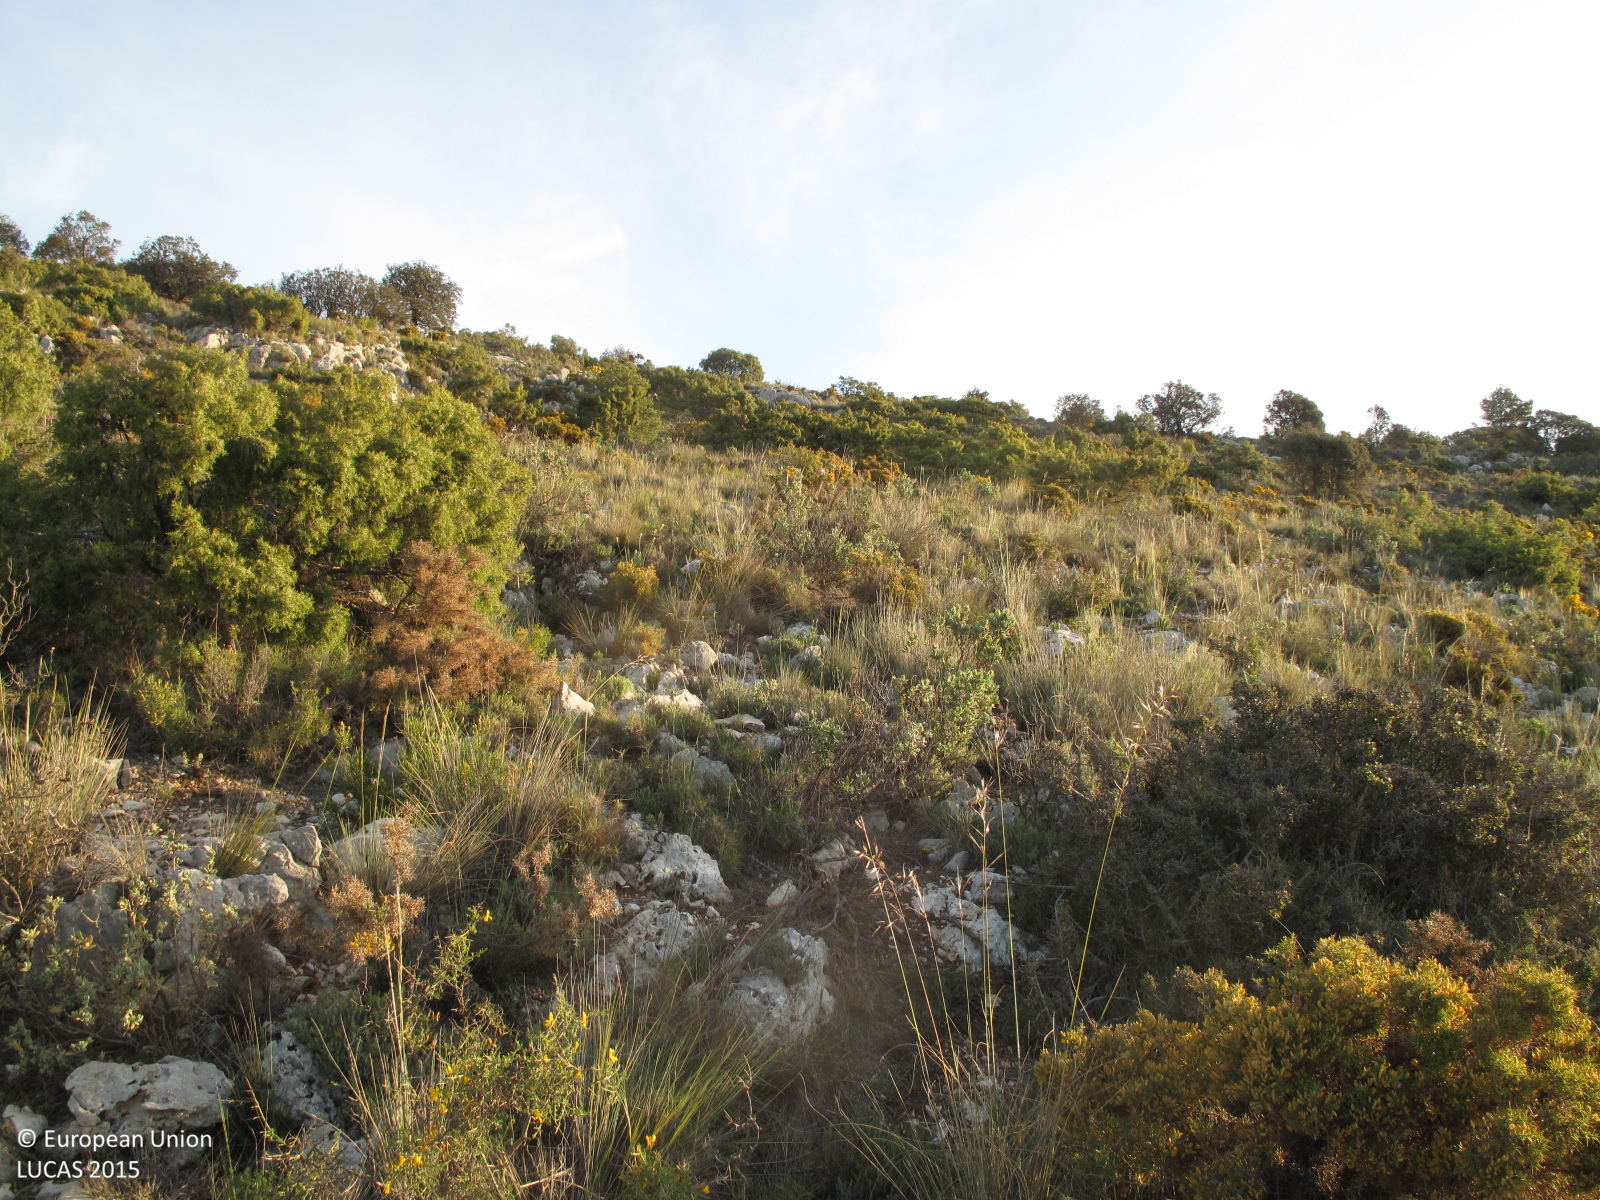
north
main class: Shrubland
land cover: Shrubland with sparse tree cover
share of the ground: 10 - 25 %
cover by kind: herbaceous plants 50 %, consolidated bare surface 25 %, shrubs 20 %, coniferous forest trees 5 %
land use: Semi-natural and natural areas not in use
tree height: < 5 m
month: May
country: ES
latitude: 38.6570
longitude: -0.5498
